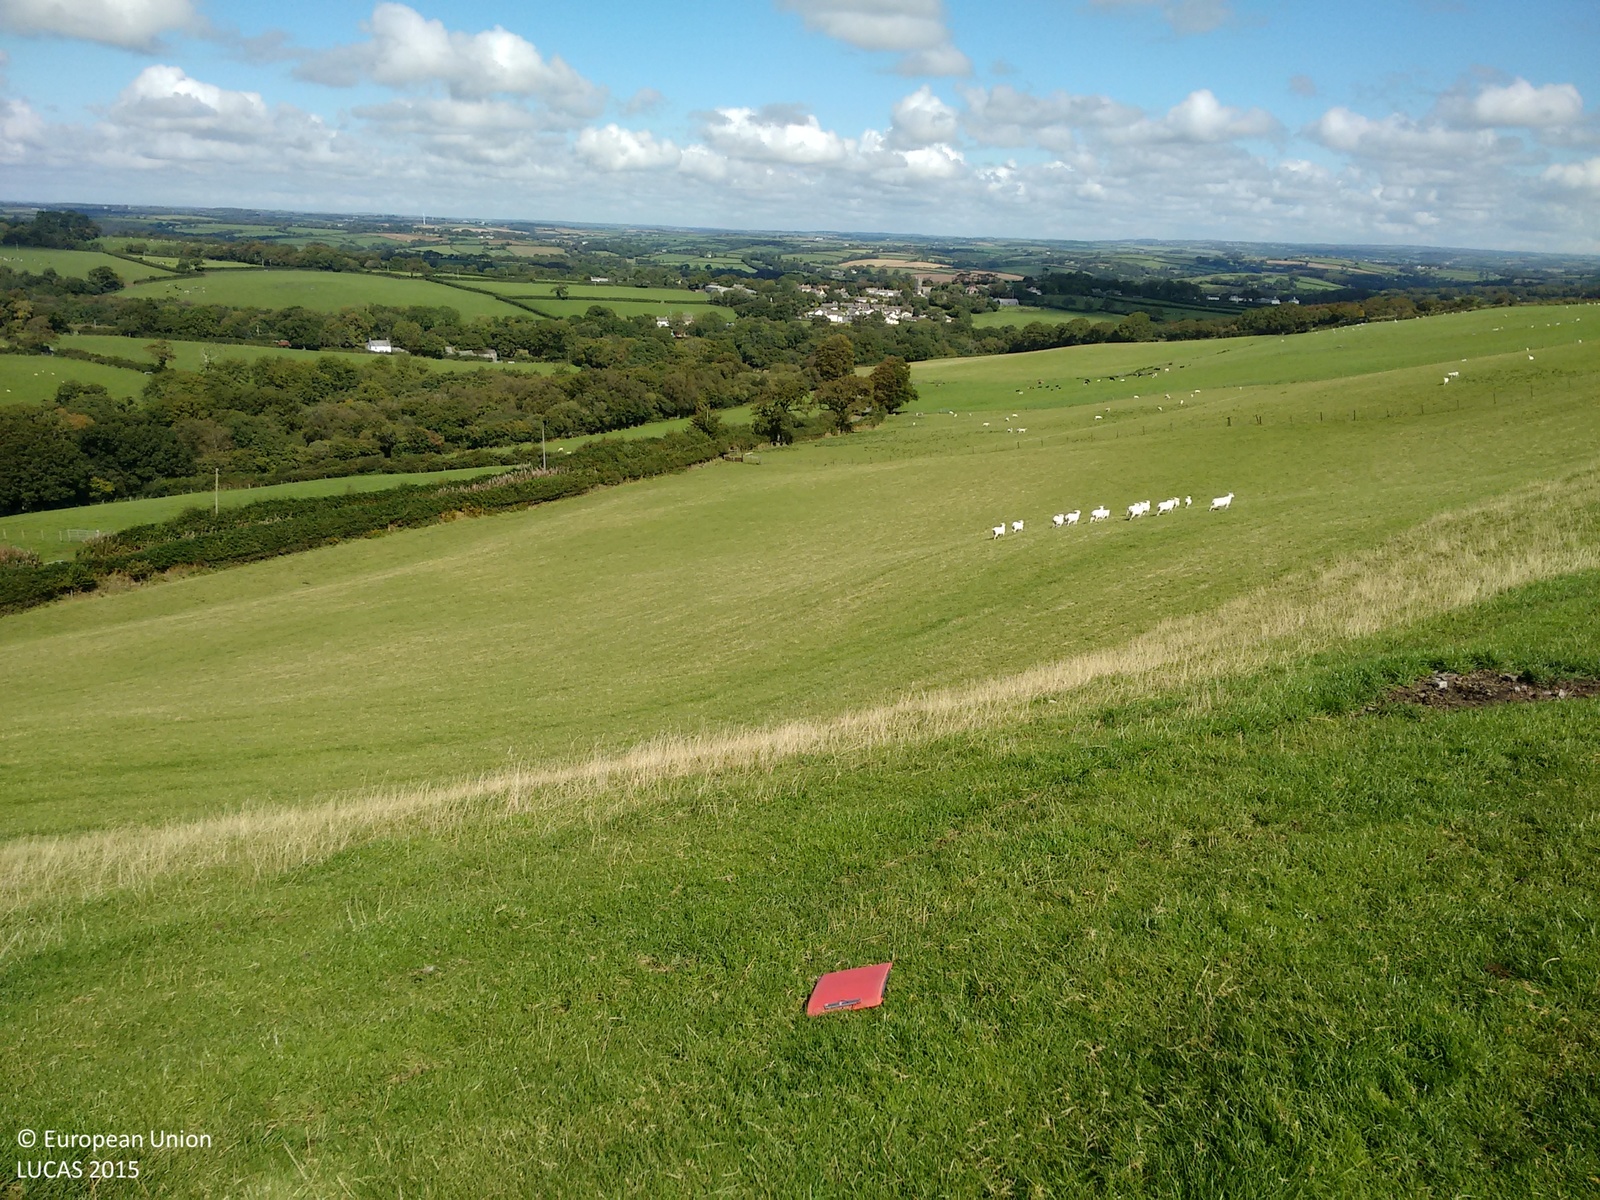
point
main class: Grassland
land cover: Grassland without tree/shrub cover
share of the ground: > 75 %
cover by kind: herbaceous plants 100 %
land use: Agriculture (excluding fallow land and kitchen gardens)
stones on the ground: < 10 %
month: September
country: GB
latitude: 50.6452
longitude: -4.4577
